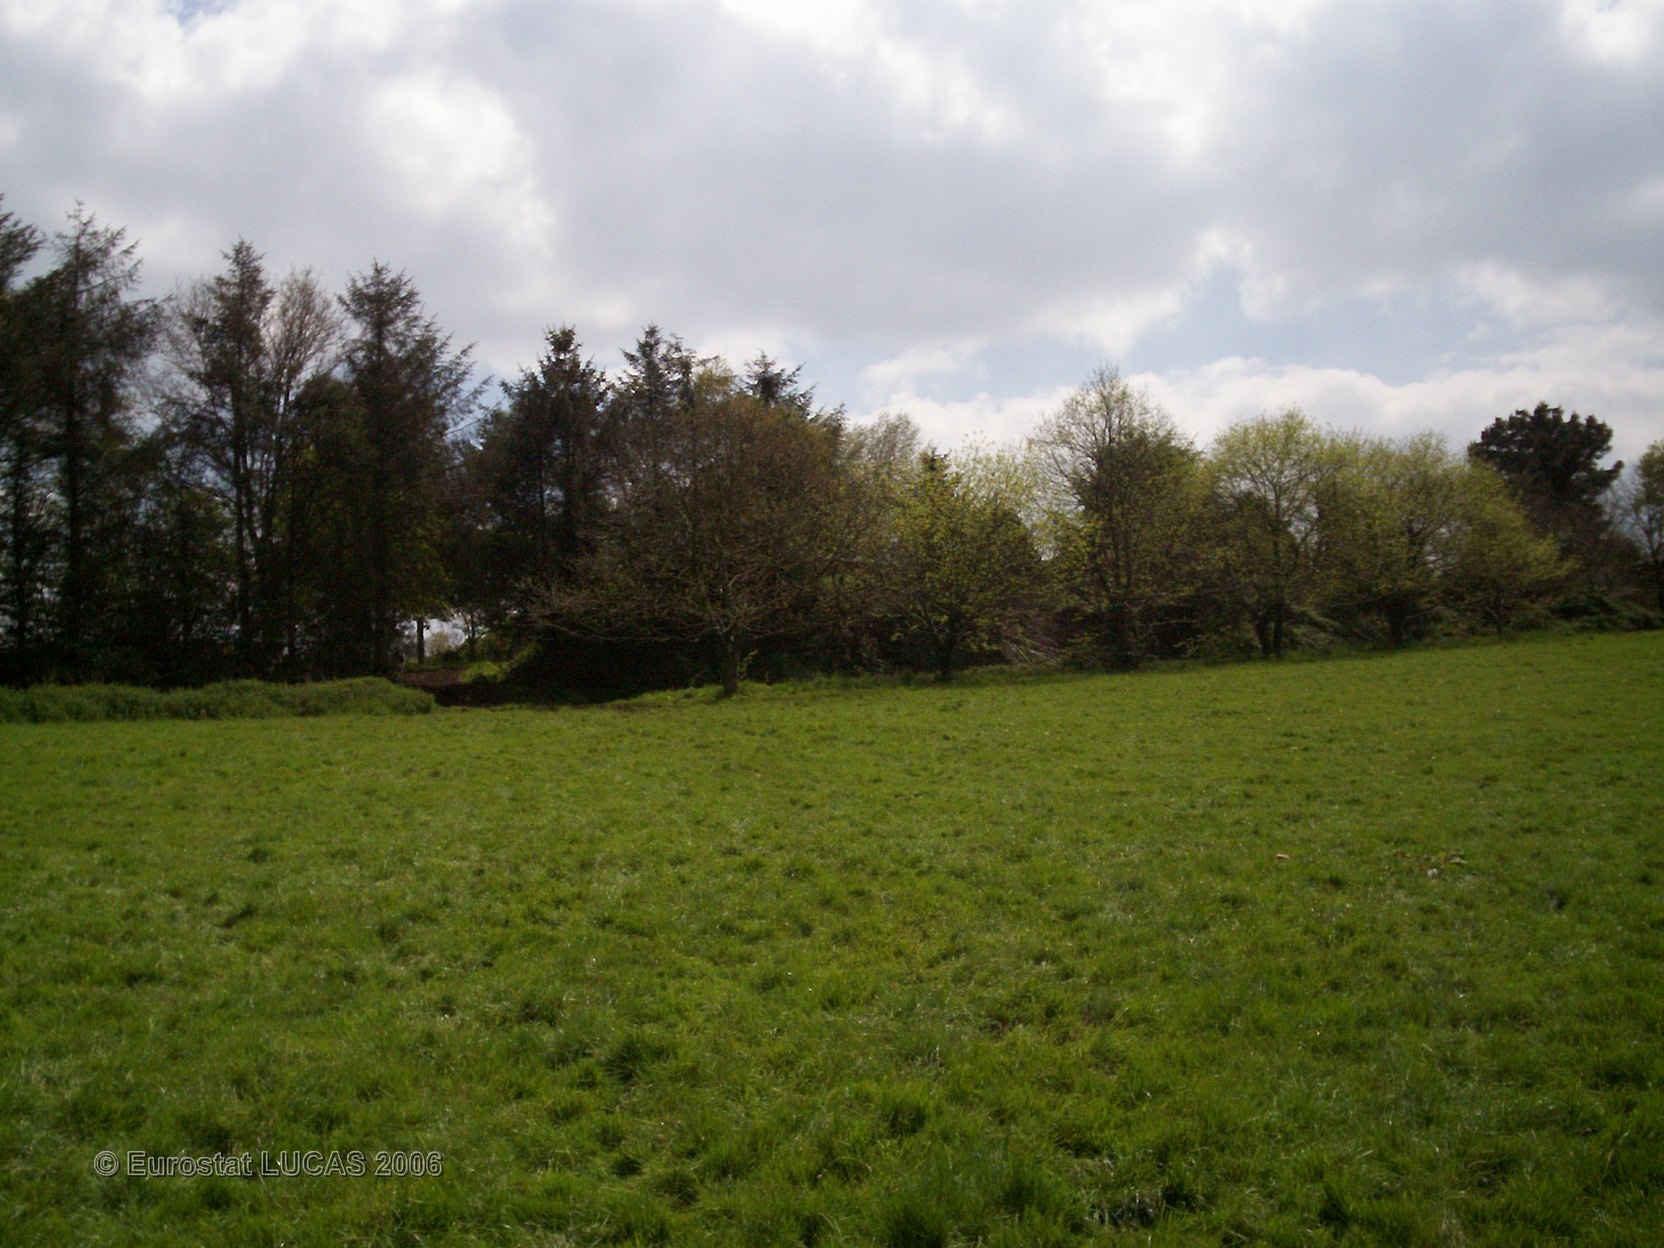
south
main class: Grassland
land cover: Grassland without tree/shrub cover
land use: Agriculture (excluding fallow land and kitchen gardens)
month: May
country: FR
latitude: 48.3523
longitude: -3.6706
